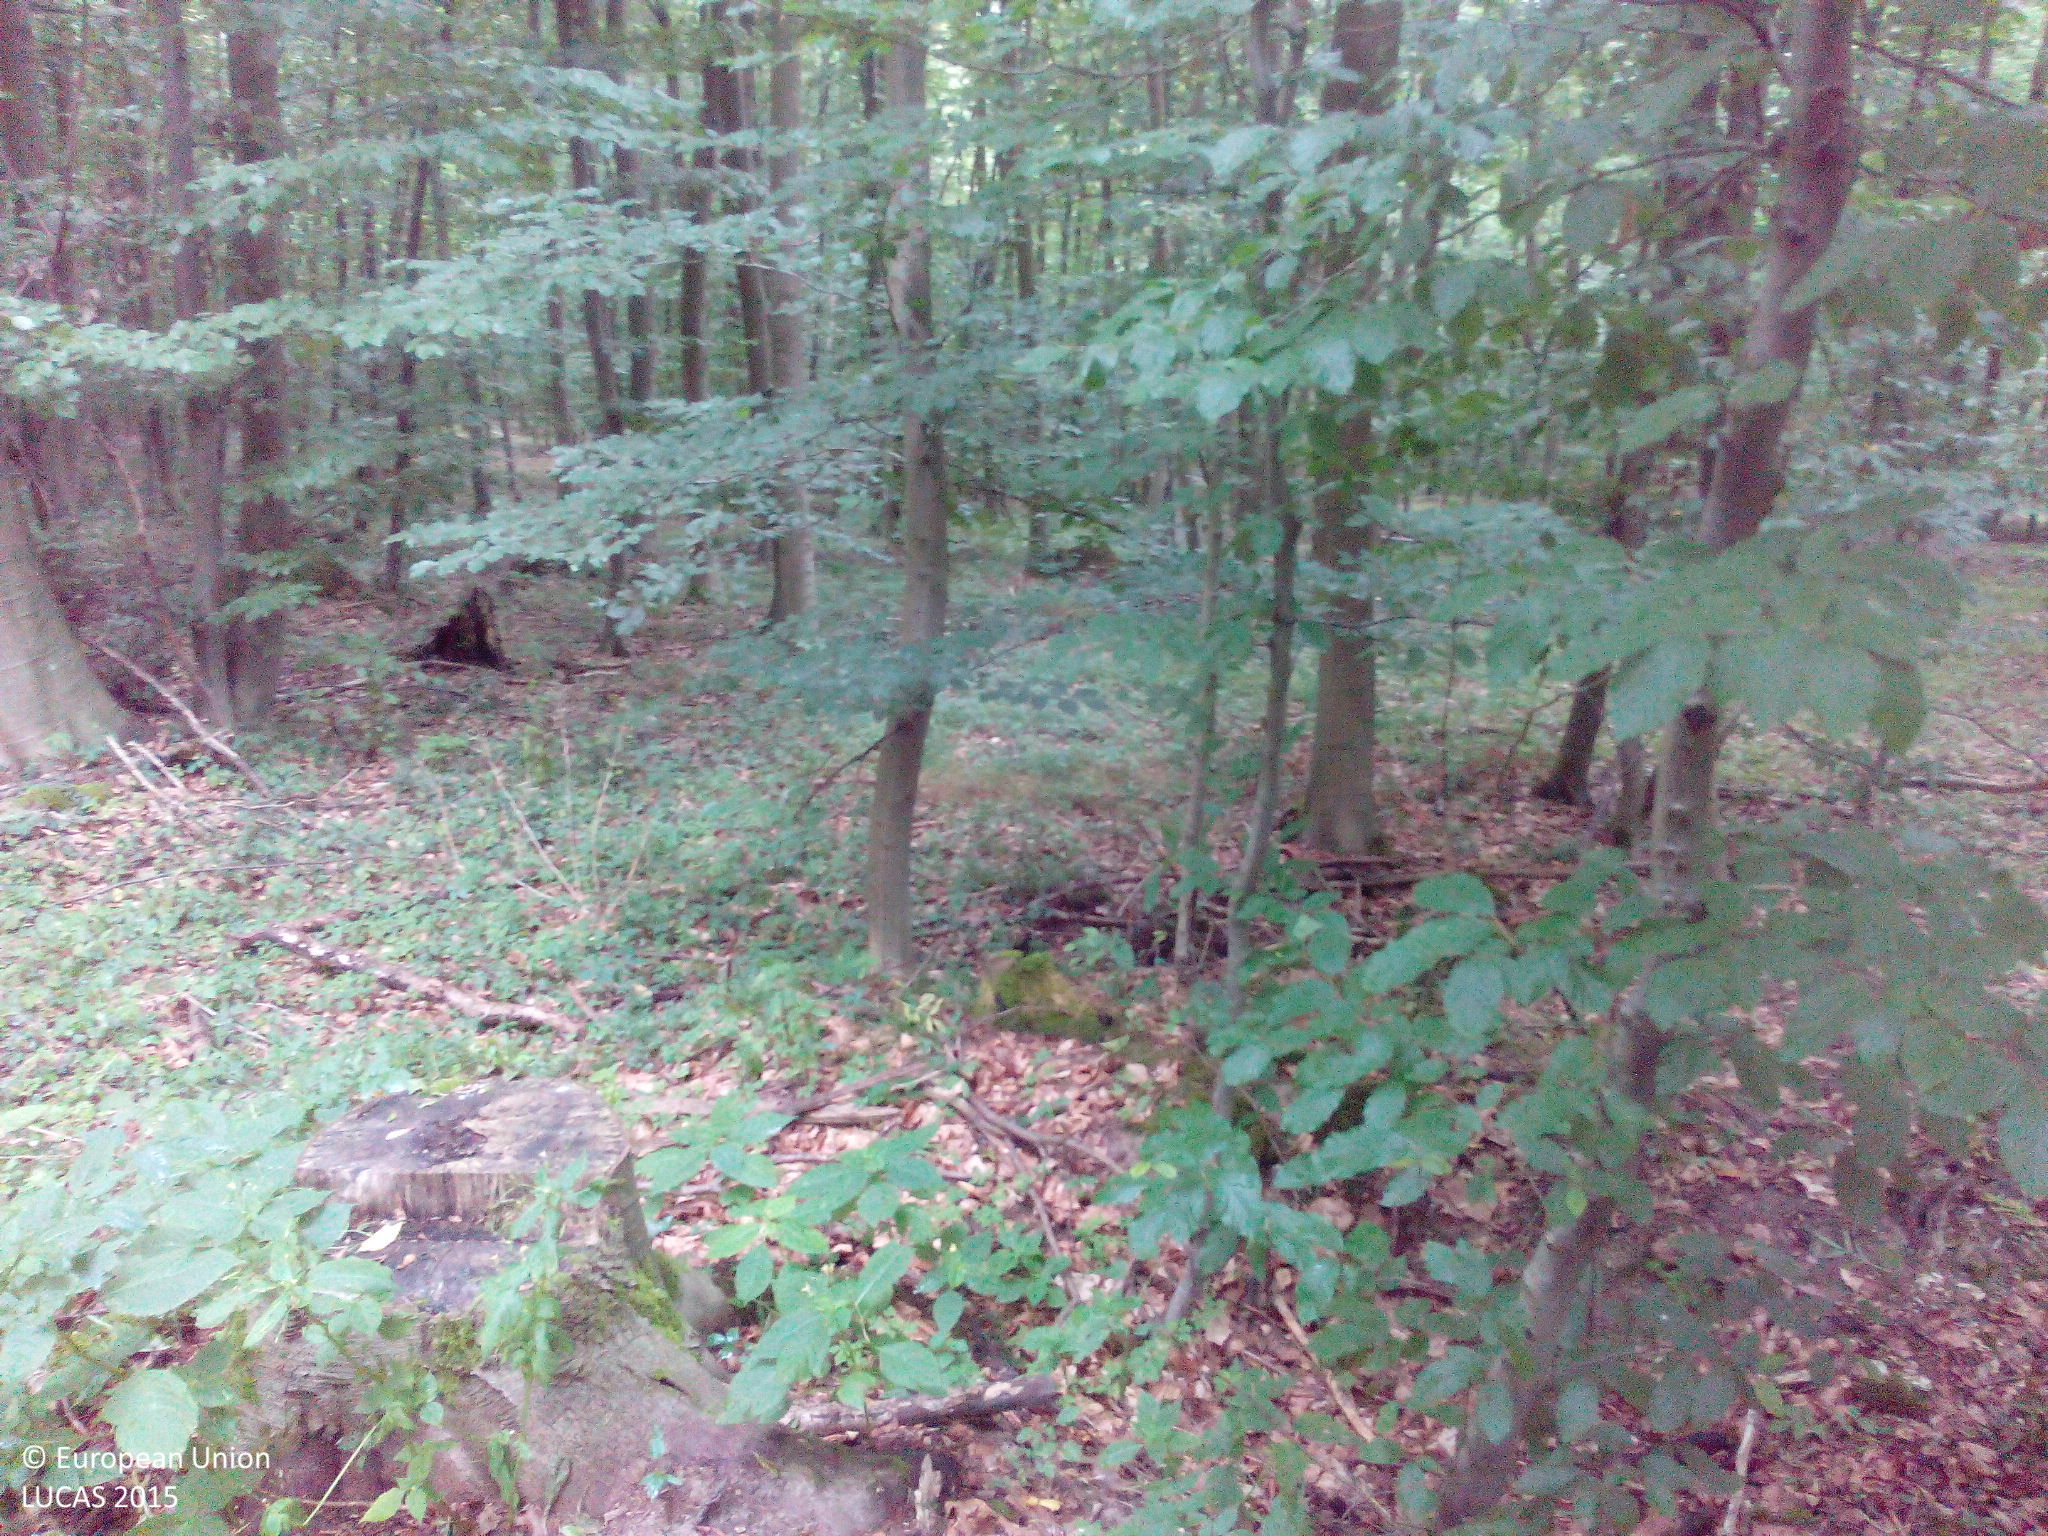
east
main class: Woodland
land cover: Broadleaved woodland
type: beech forest
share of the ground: > 75 %
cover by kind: broadleaved forest trees 85 %, unconsolidated bare surface 10 %, herbaceous plants 5 %
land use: Forestry
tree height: > 5 m
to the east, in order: Broadleaved woodland
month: August
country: DE
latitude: 50.3469
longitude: 8.0189
